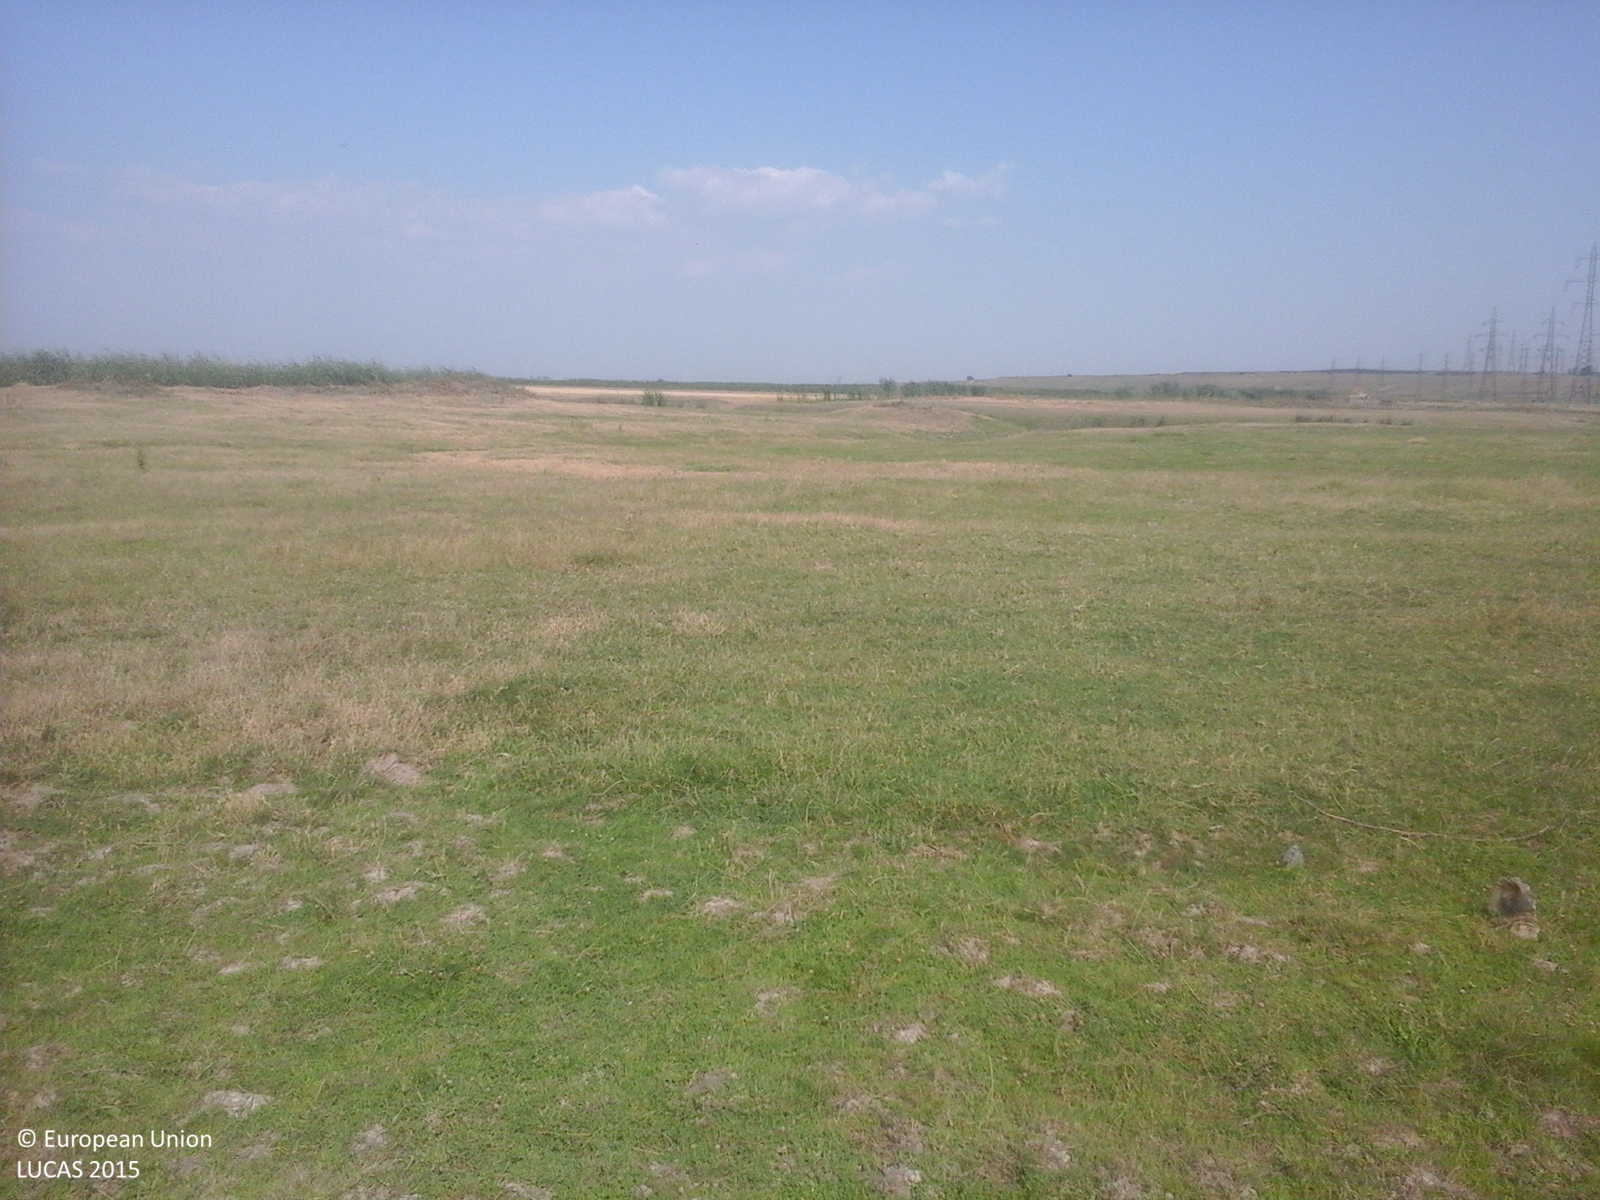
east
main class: Grassland
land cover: Grassland without tree/shrub cover
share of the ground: > 75 %
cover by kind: herbaceous plants 90 %, unconsolidated bare surface 10 %
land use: Agriculture (excluding fallow land and kitchen gardens)
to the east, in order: Grassland without tree/shrub cover; Tracks; Grassland without tree/shrub cover; Inland fresh running water; Grassland without tree/shrub cover; Ditches and canals; Grass margins; Tracks; Durum wheat
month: July
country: RO
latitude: 44.9023
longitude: 27.6671
